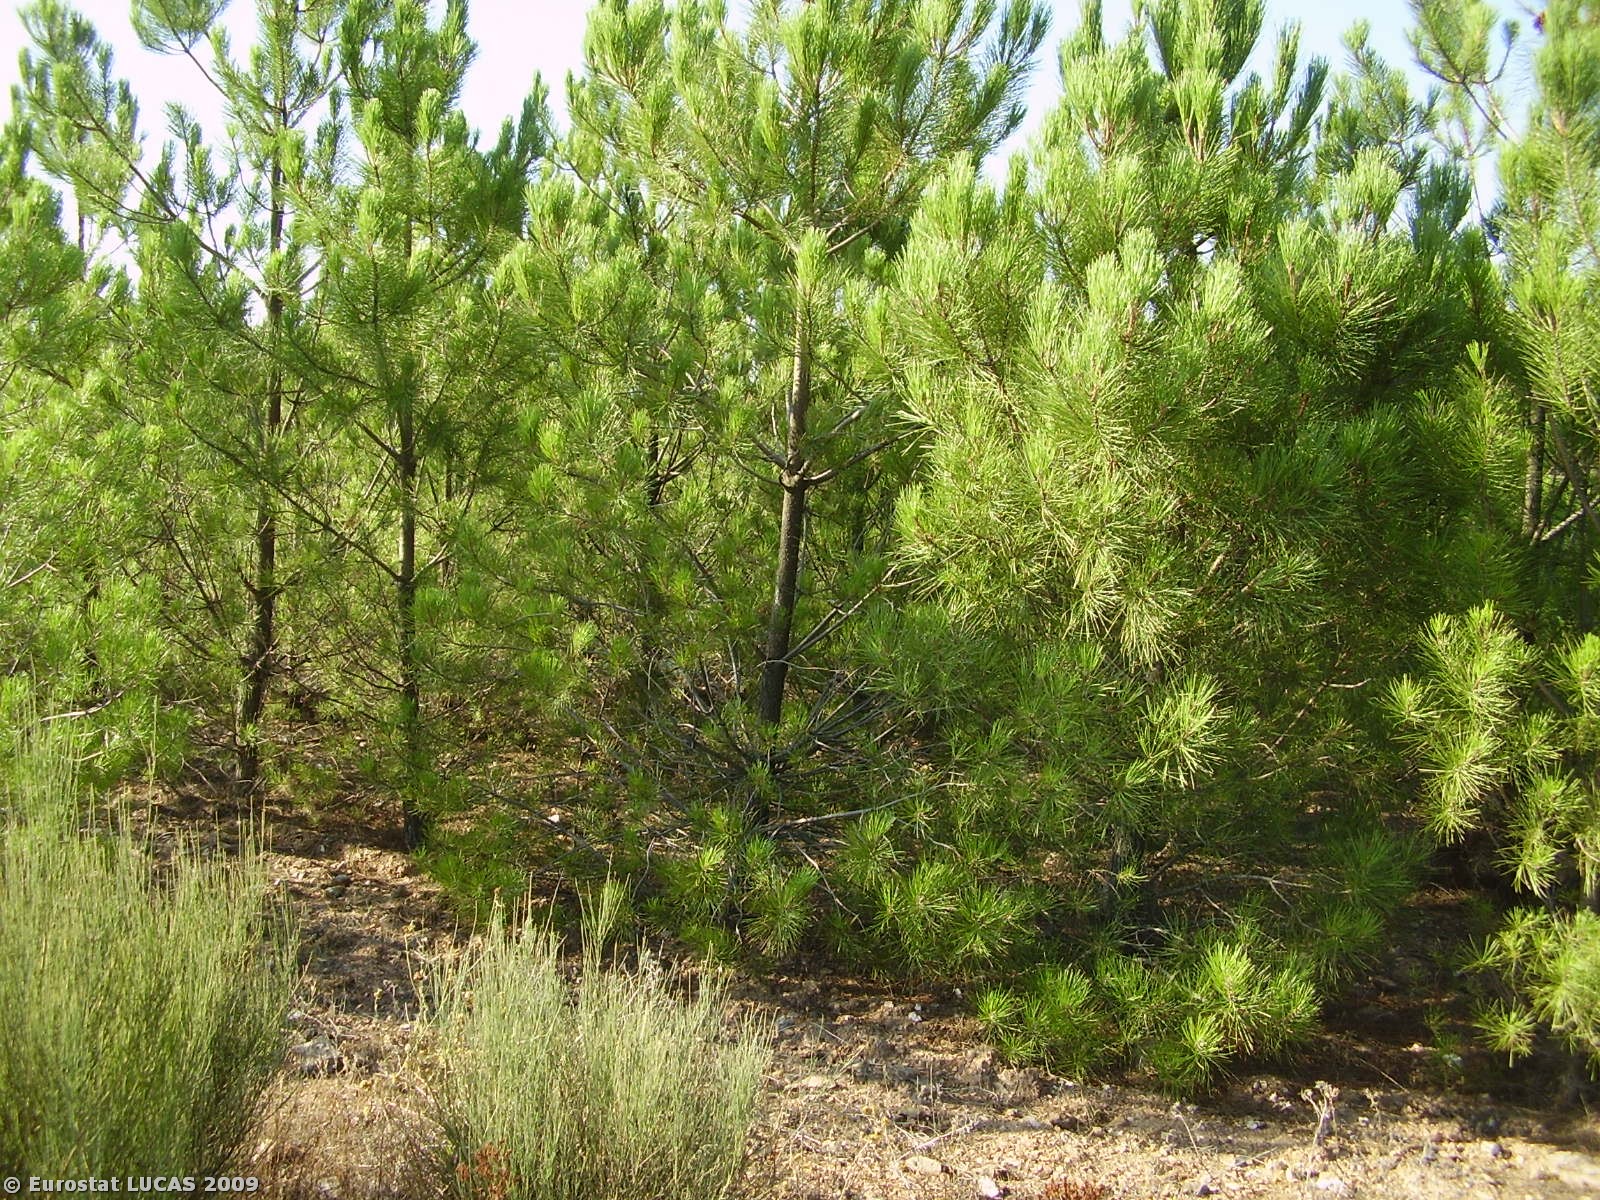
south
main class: Shrubland
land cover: Shrubland with sparse tree cover
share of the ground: > 75 %
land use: Fallow land
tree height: > 5 m
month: August
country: PT
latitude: 41.3567
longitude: -6.7573
